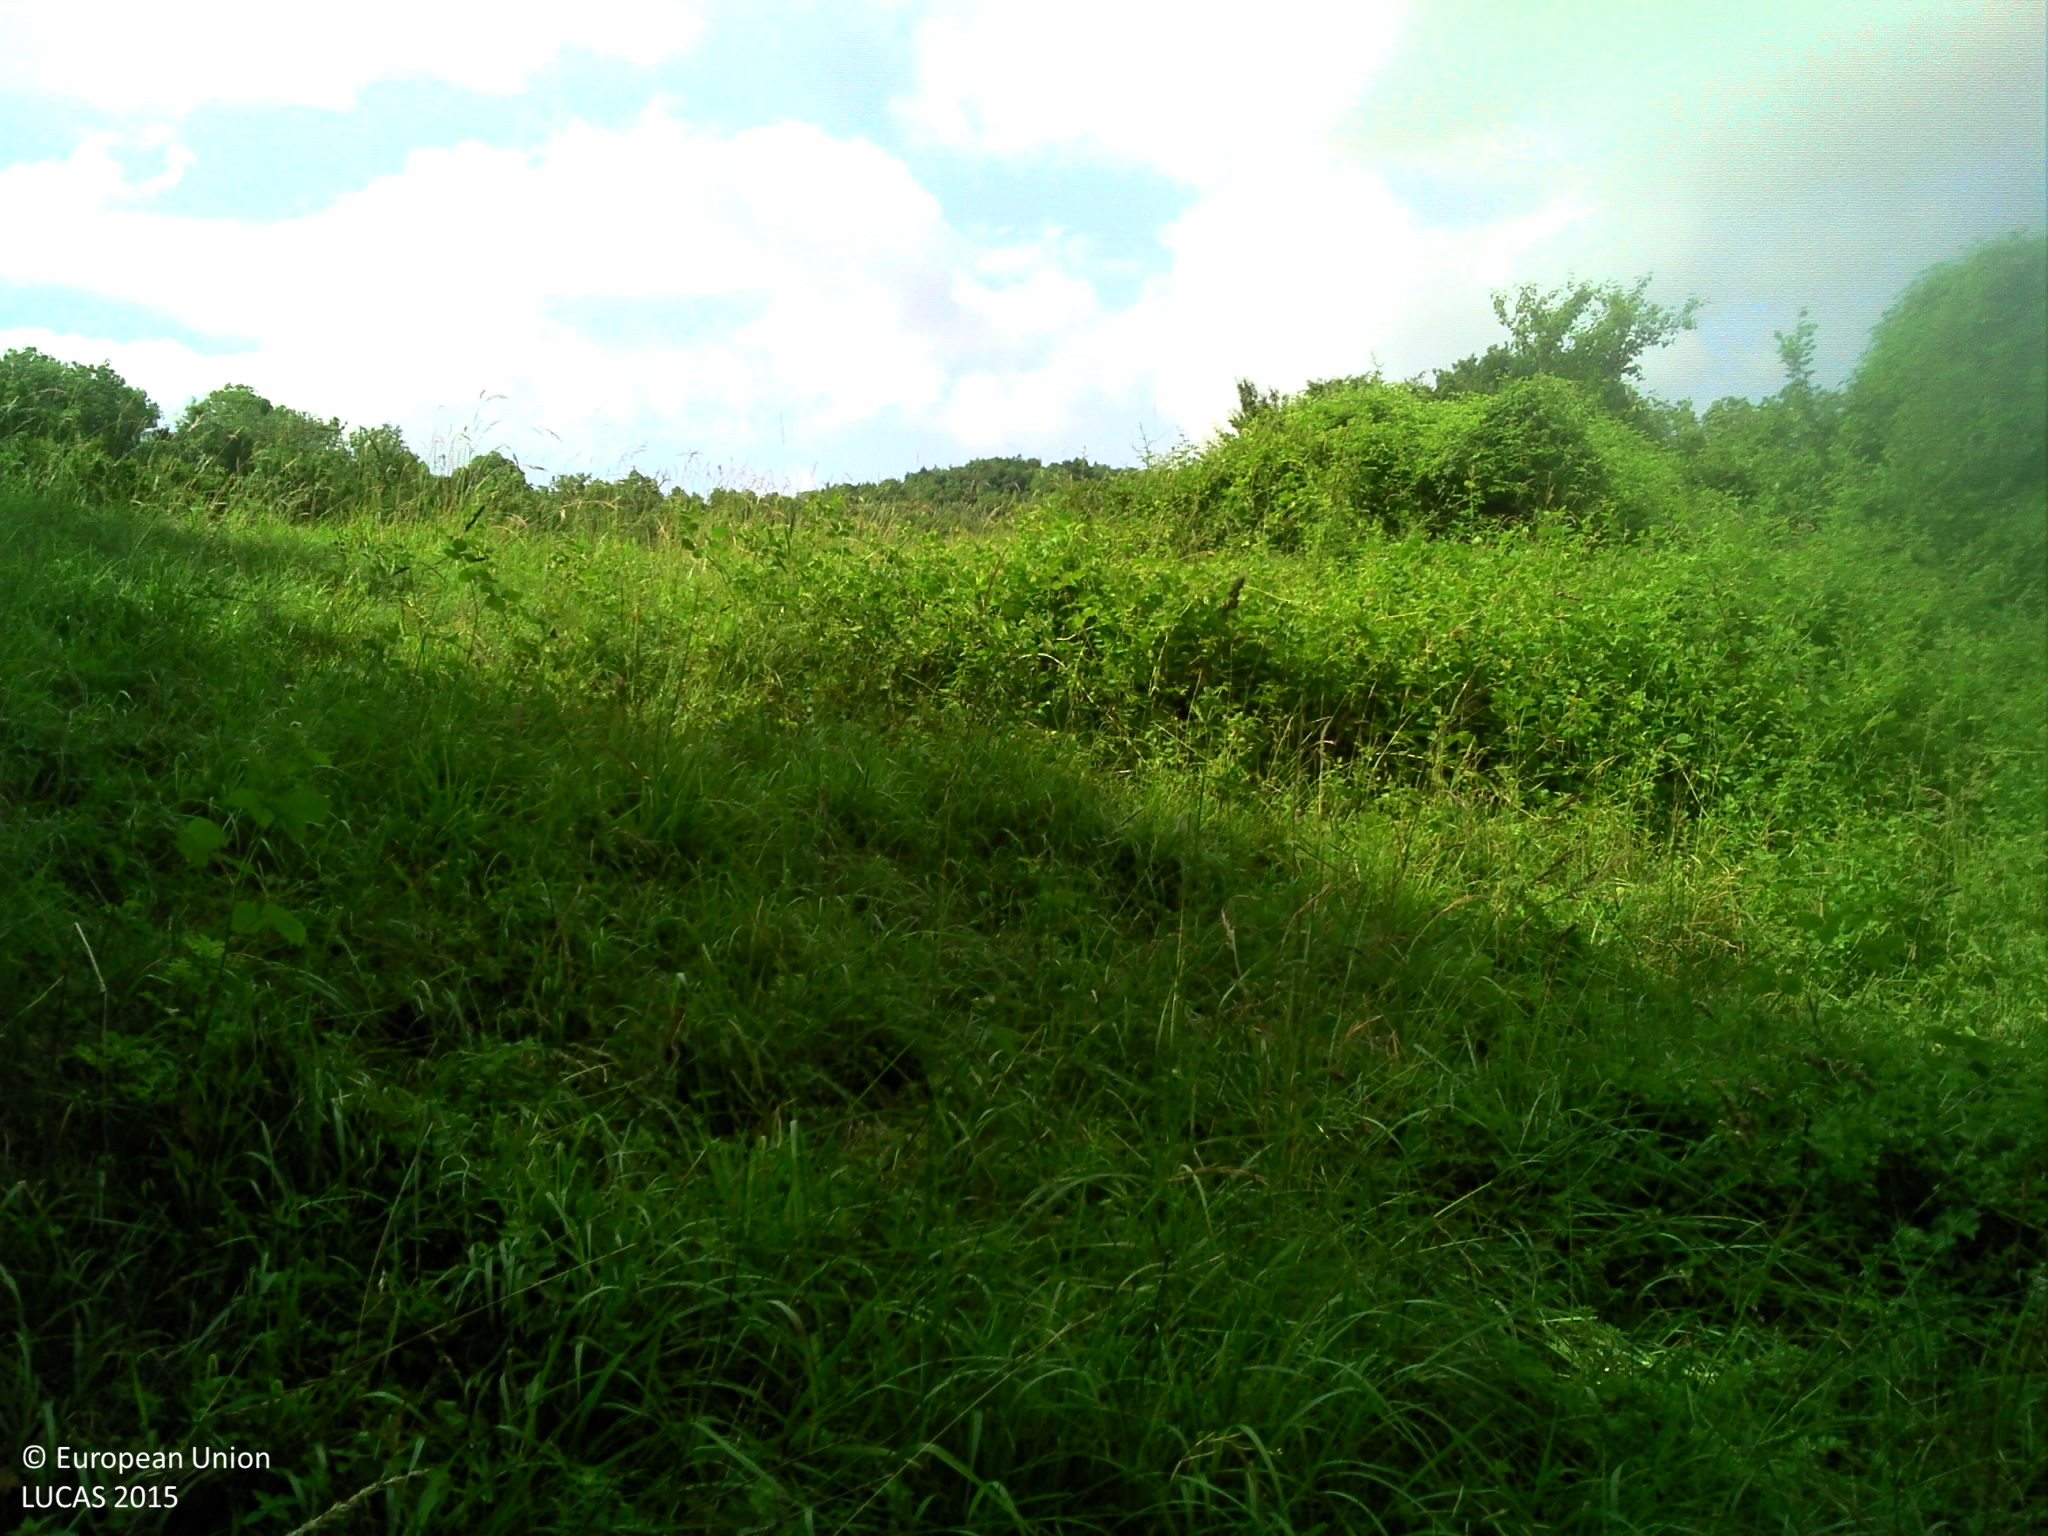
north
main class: Grassland
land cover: Spontaneously vegetated surfaces
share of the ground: > 75 %
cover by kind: herbaceous plants 95 %, shrubs 5 %
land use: Abandoned areas
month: June
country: FR
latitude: 45.5065
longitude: 6.1521
